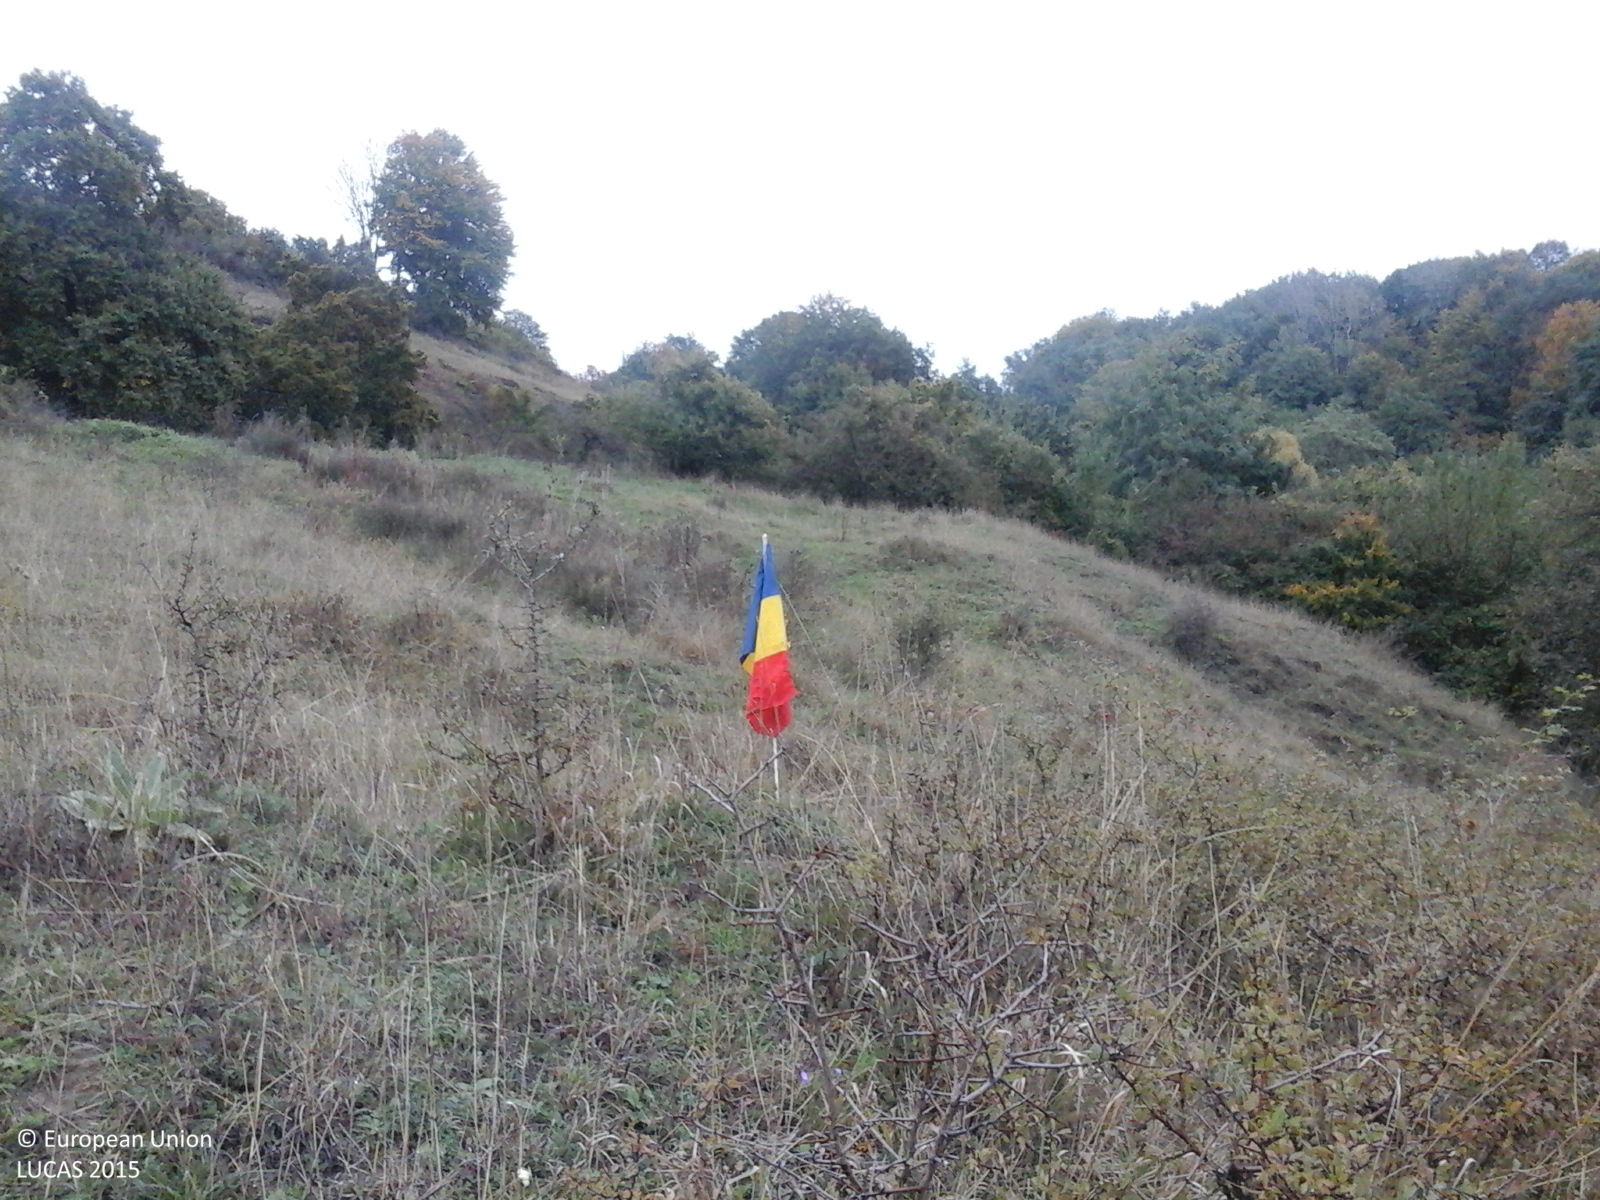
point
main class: Grassland
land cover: Grassland with sparse tree/shrub cover
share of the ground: > 75 %
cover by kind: herbaceous plants 85 %, shrubs 10 %, broadleaved forest trees 5 %
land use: Agriculture (excluding fallow land and kitchen gardens)
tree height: < 5 m
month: October
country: RO
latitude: 46.0518
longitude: 24.2306
